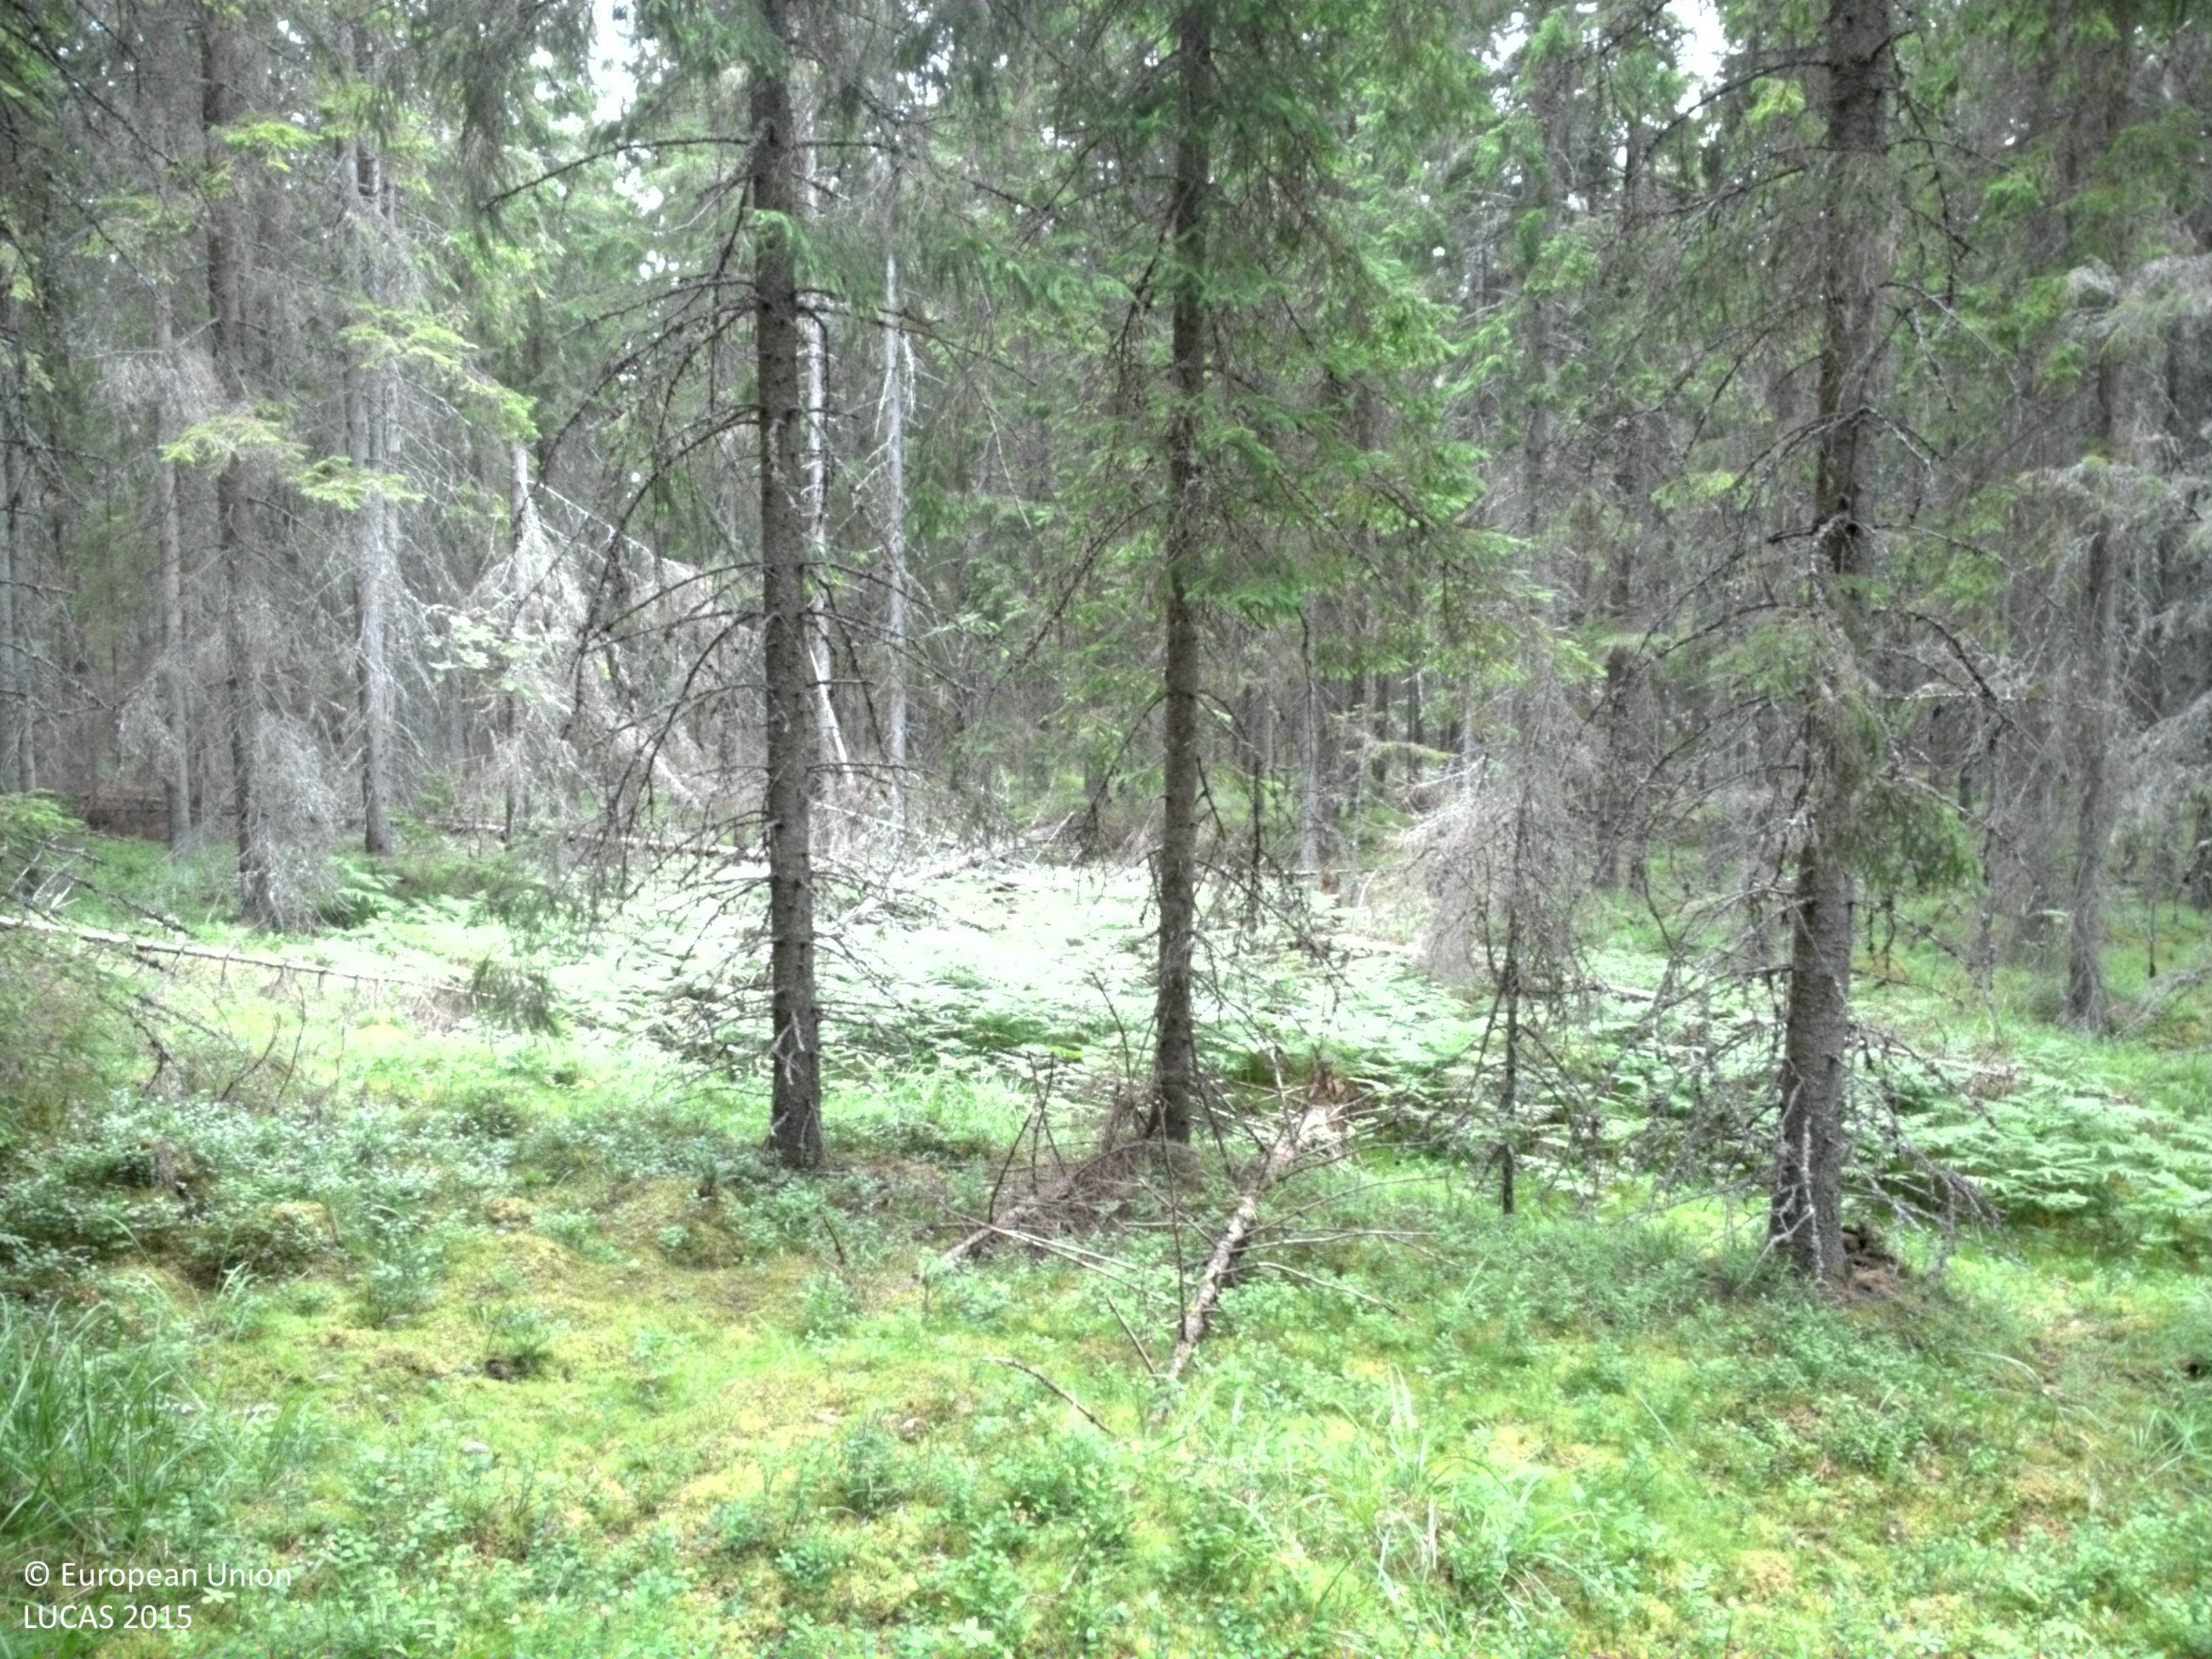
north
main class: Woodland
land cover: Spruce dominated coniferous woodland
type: boreal forest
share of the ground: 50 - 75 %
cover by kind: coniferous forest trees 75 %, lichens and mosses 15 %, herbaceous plants 10 %
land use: Forestry
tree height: > 5 m
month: July
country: SE
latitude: 60.0556
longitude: 18.4203
